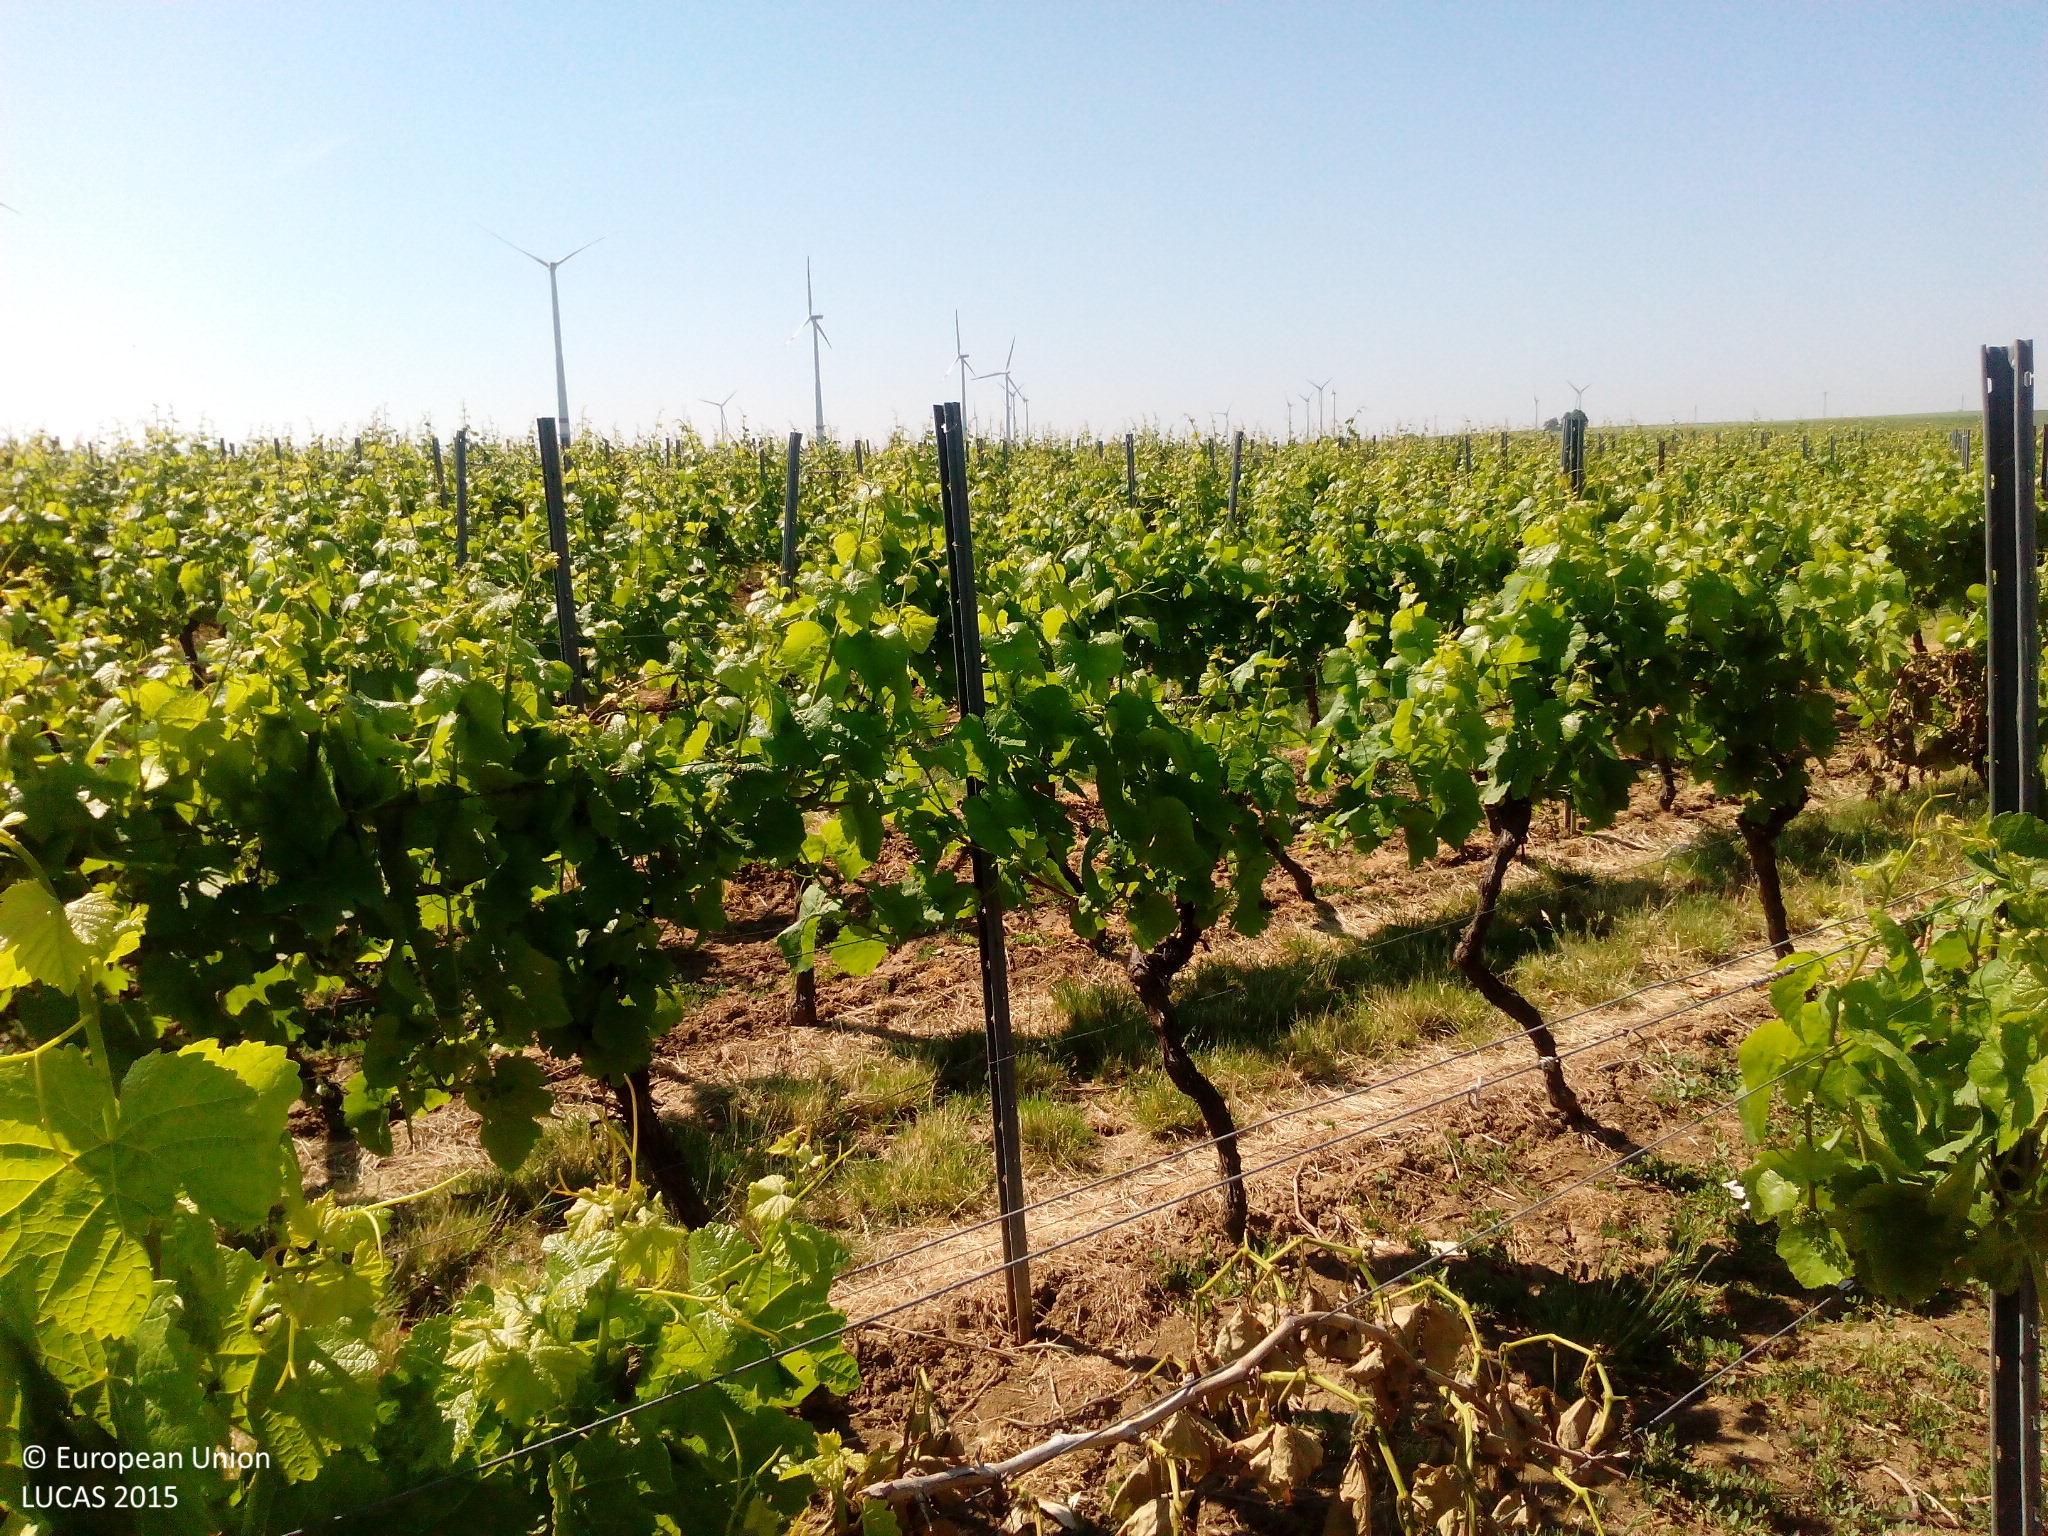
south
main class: Cropland
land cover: Vineyards
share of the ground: 50 - 75 %
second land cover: Grassland without tree/shrub cover
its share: 50 - 75 %
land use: Agriculture (excluding fallow land and kitchen gardens)
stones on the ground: < 10 %
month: June
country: DE
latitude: 49.8635
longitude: 8.1502
